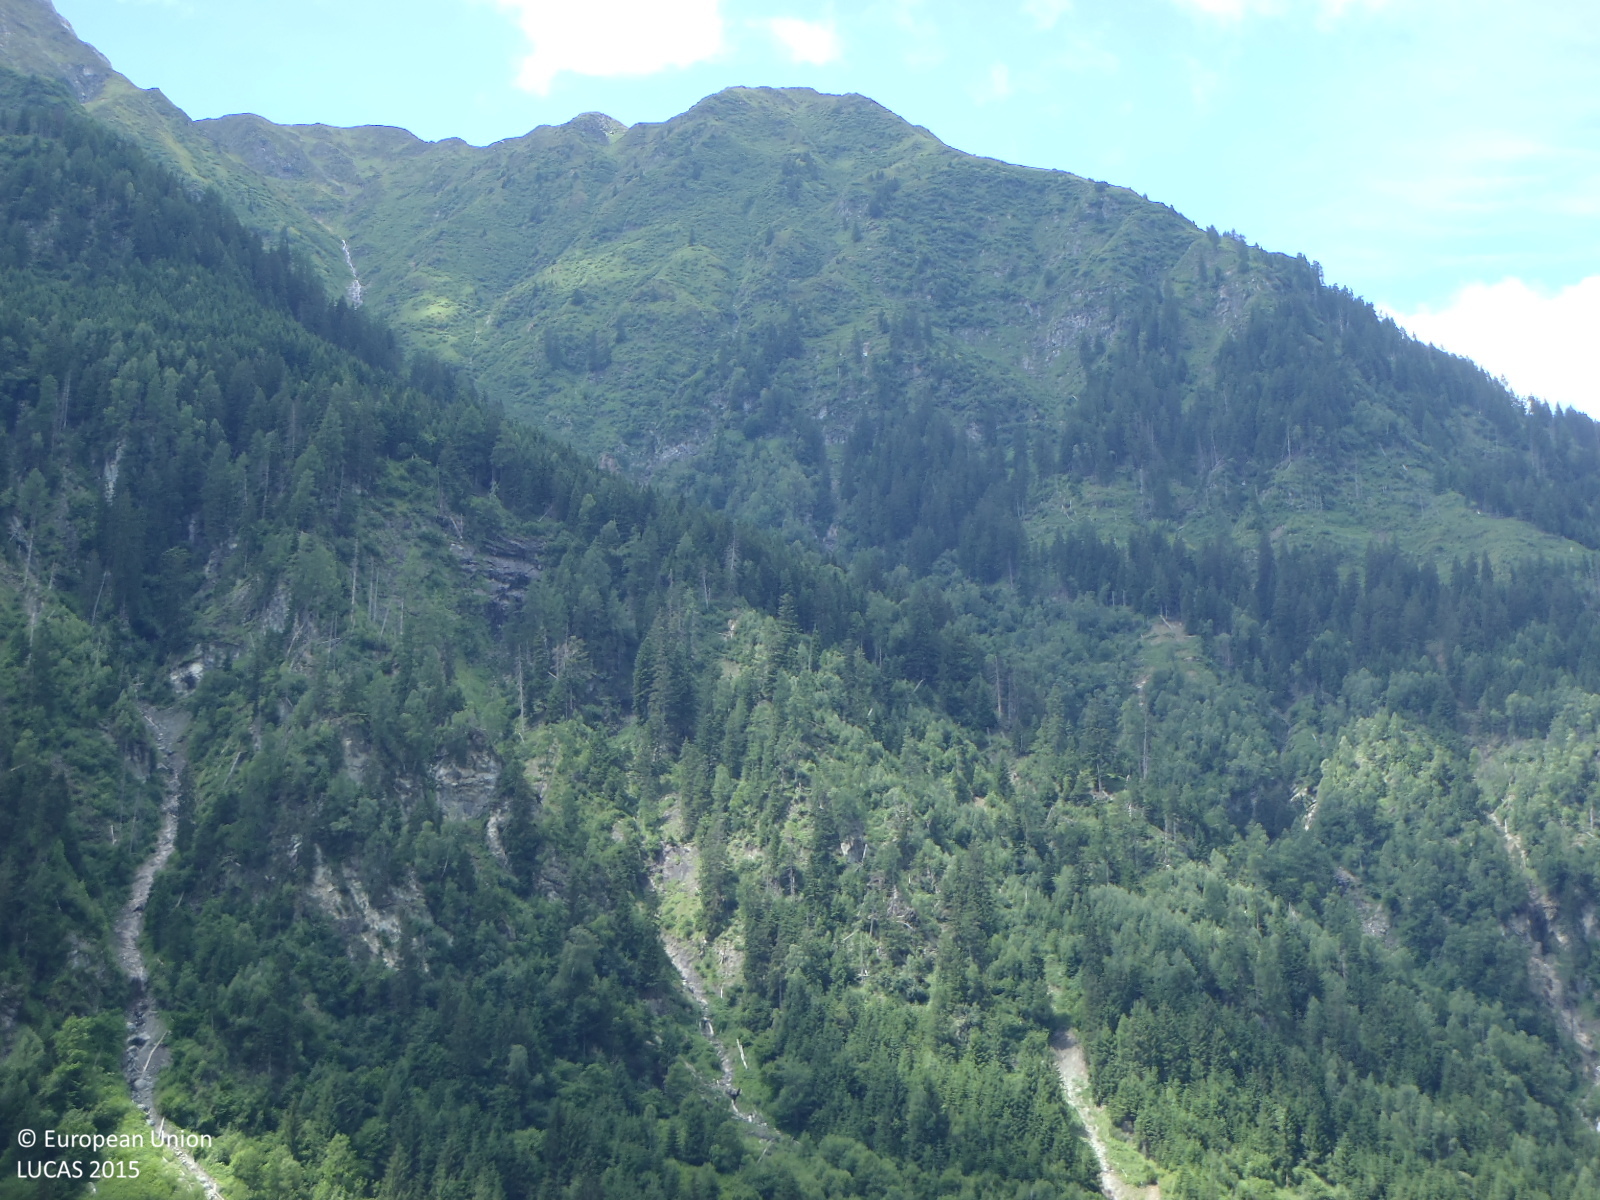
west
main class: Grassland
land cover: Grassland without tree/shrub cover
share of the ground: > 75 %
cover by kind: herbaceous plants 100 %
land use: Agriculture (excluding fallow land and kitchen gardens)
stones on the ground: < 10 %
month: June
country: AT
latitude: 47.2409
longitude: 12.4949
